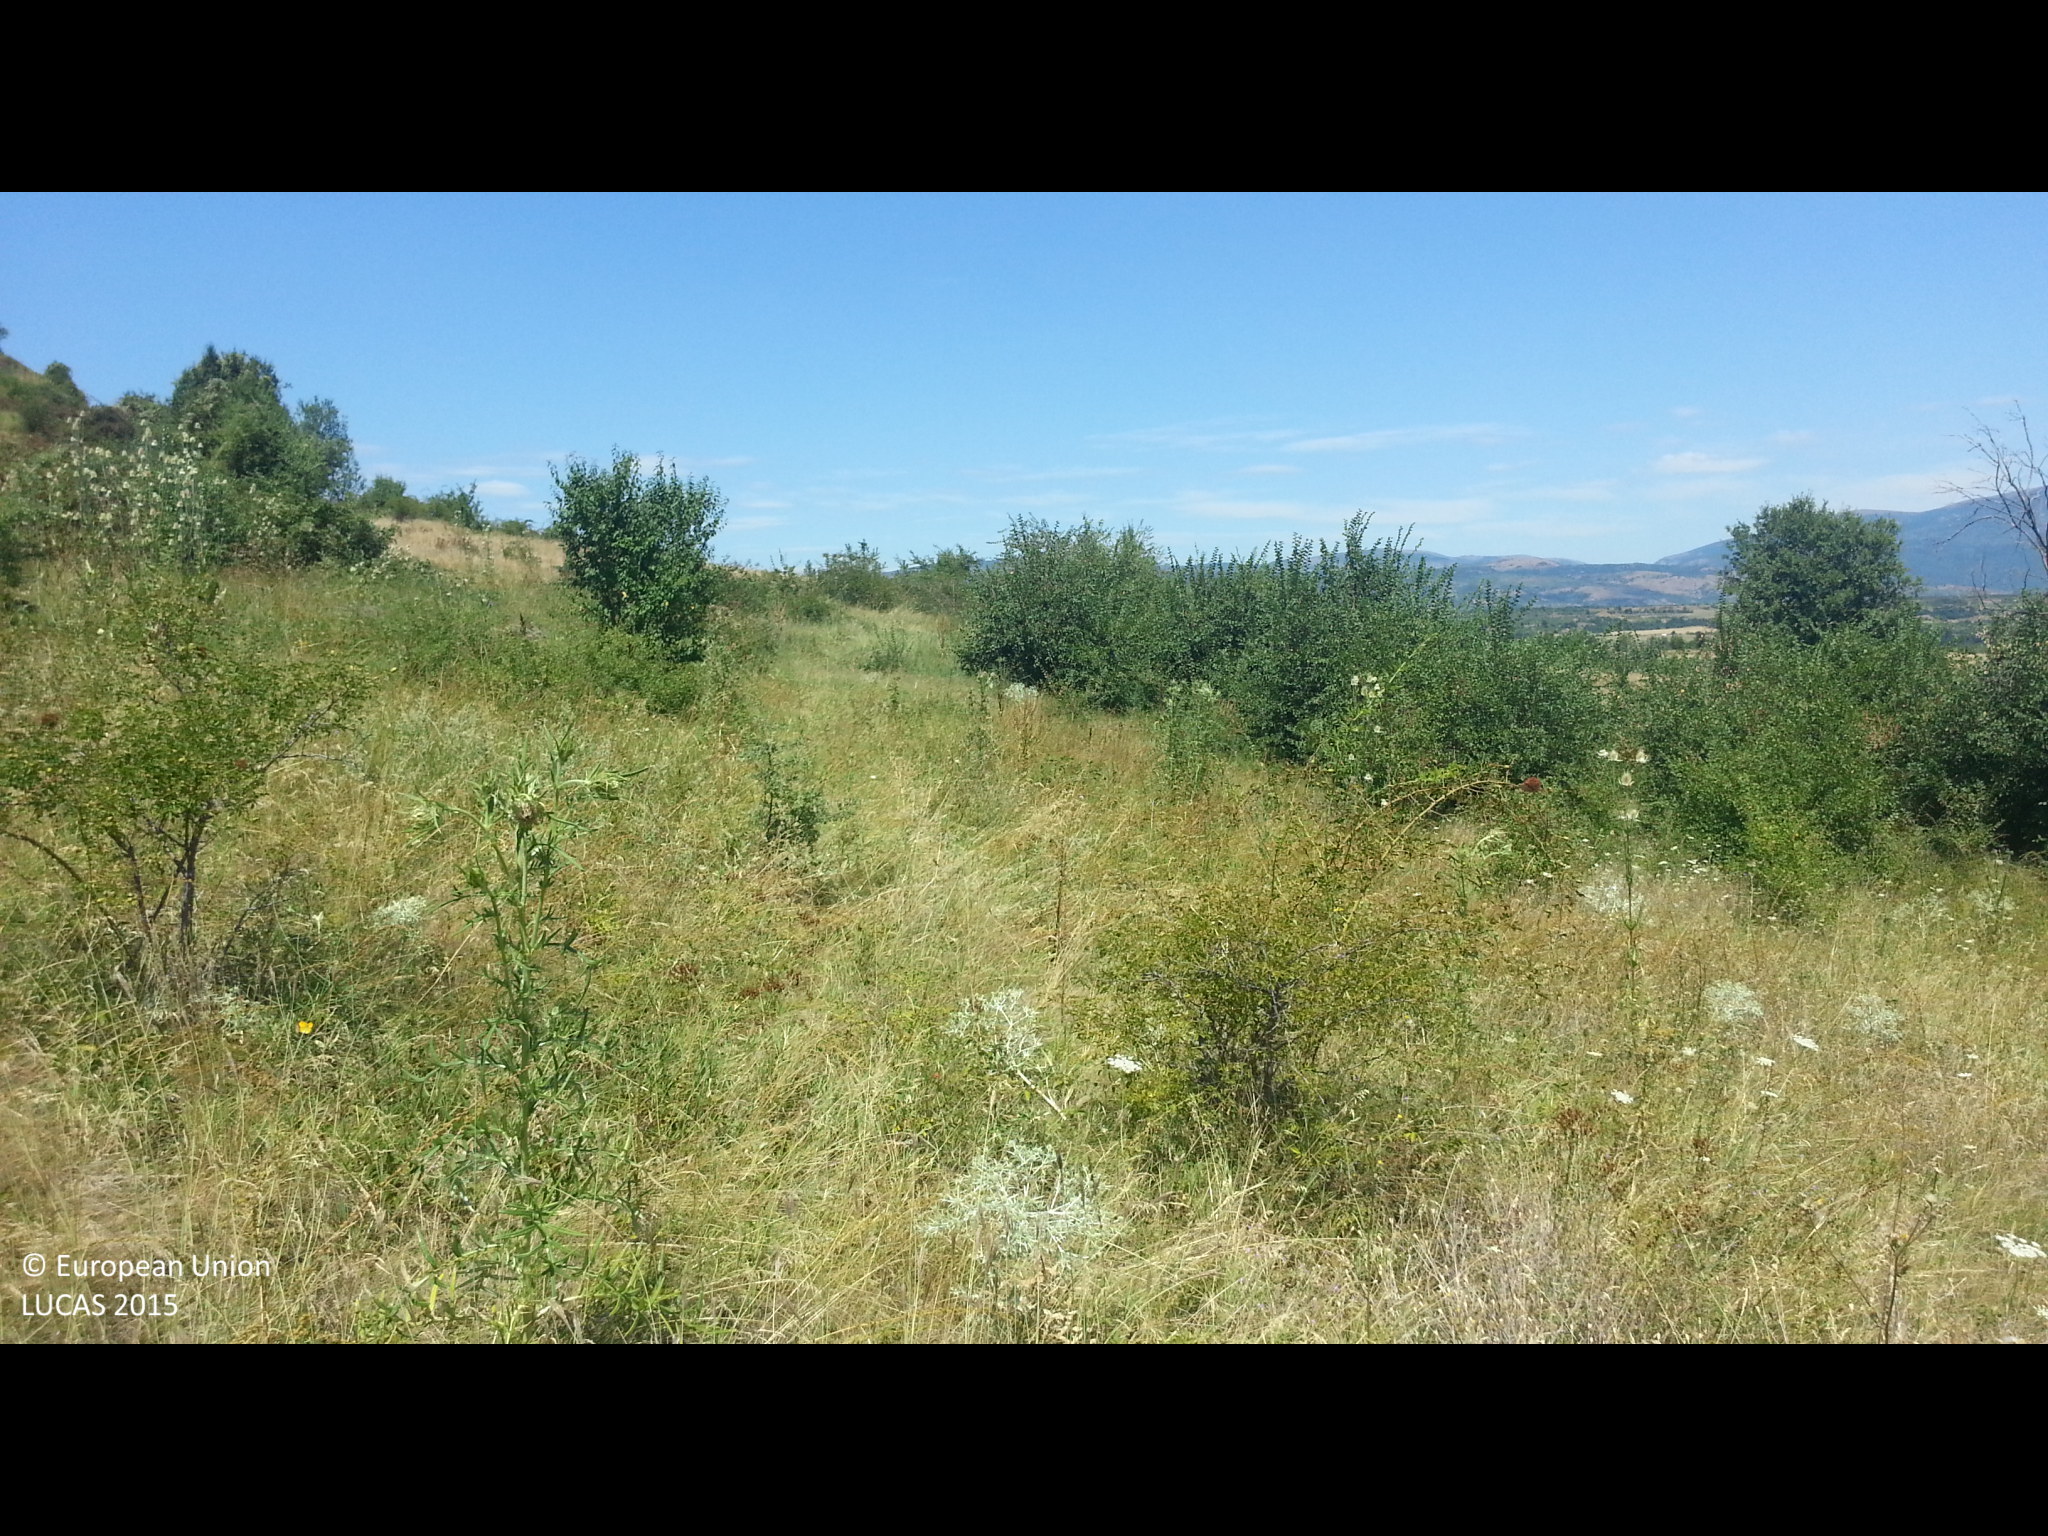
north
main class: Grassland
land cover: Grassland with sparse tree/shrub cover
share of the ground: > 75 %
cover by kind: herbaceous plants 90 %, broadleaved forest trees 5 %, shrubs 5 %
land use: Semi-natural and natural areas not in use
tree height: < 5 m
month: August
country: BG
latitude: 42.3137
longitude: 22.6515
